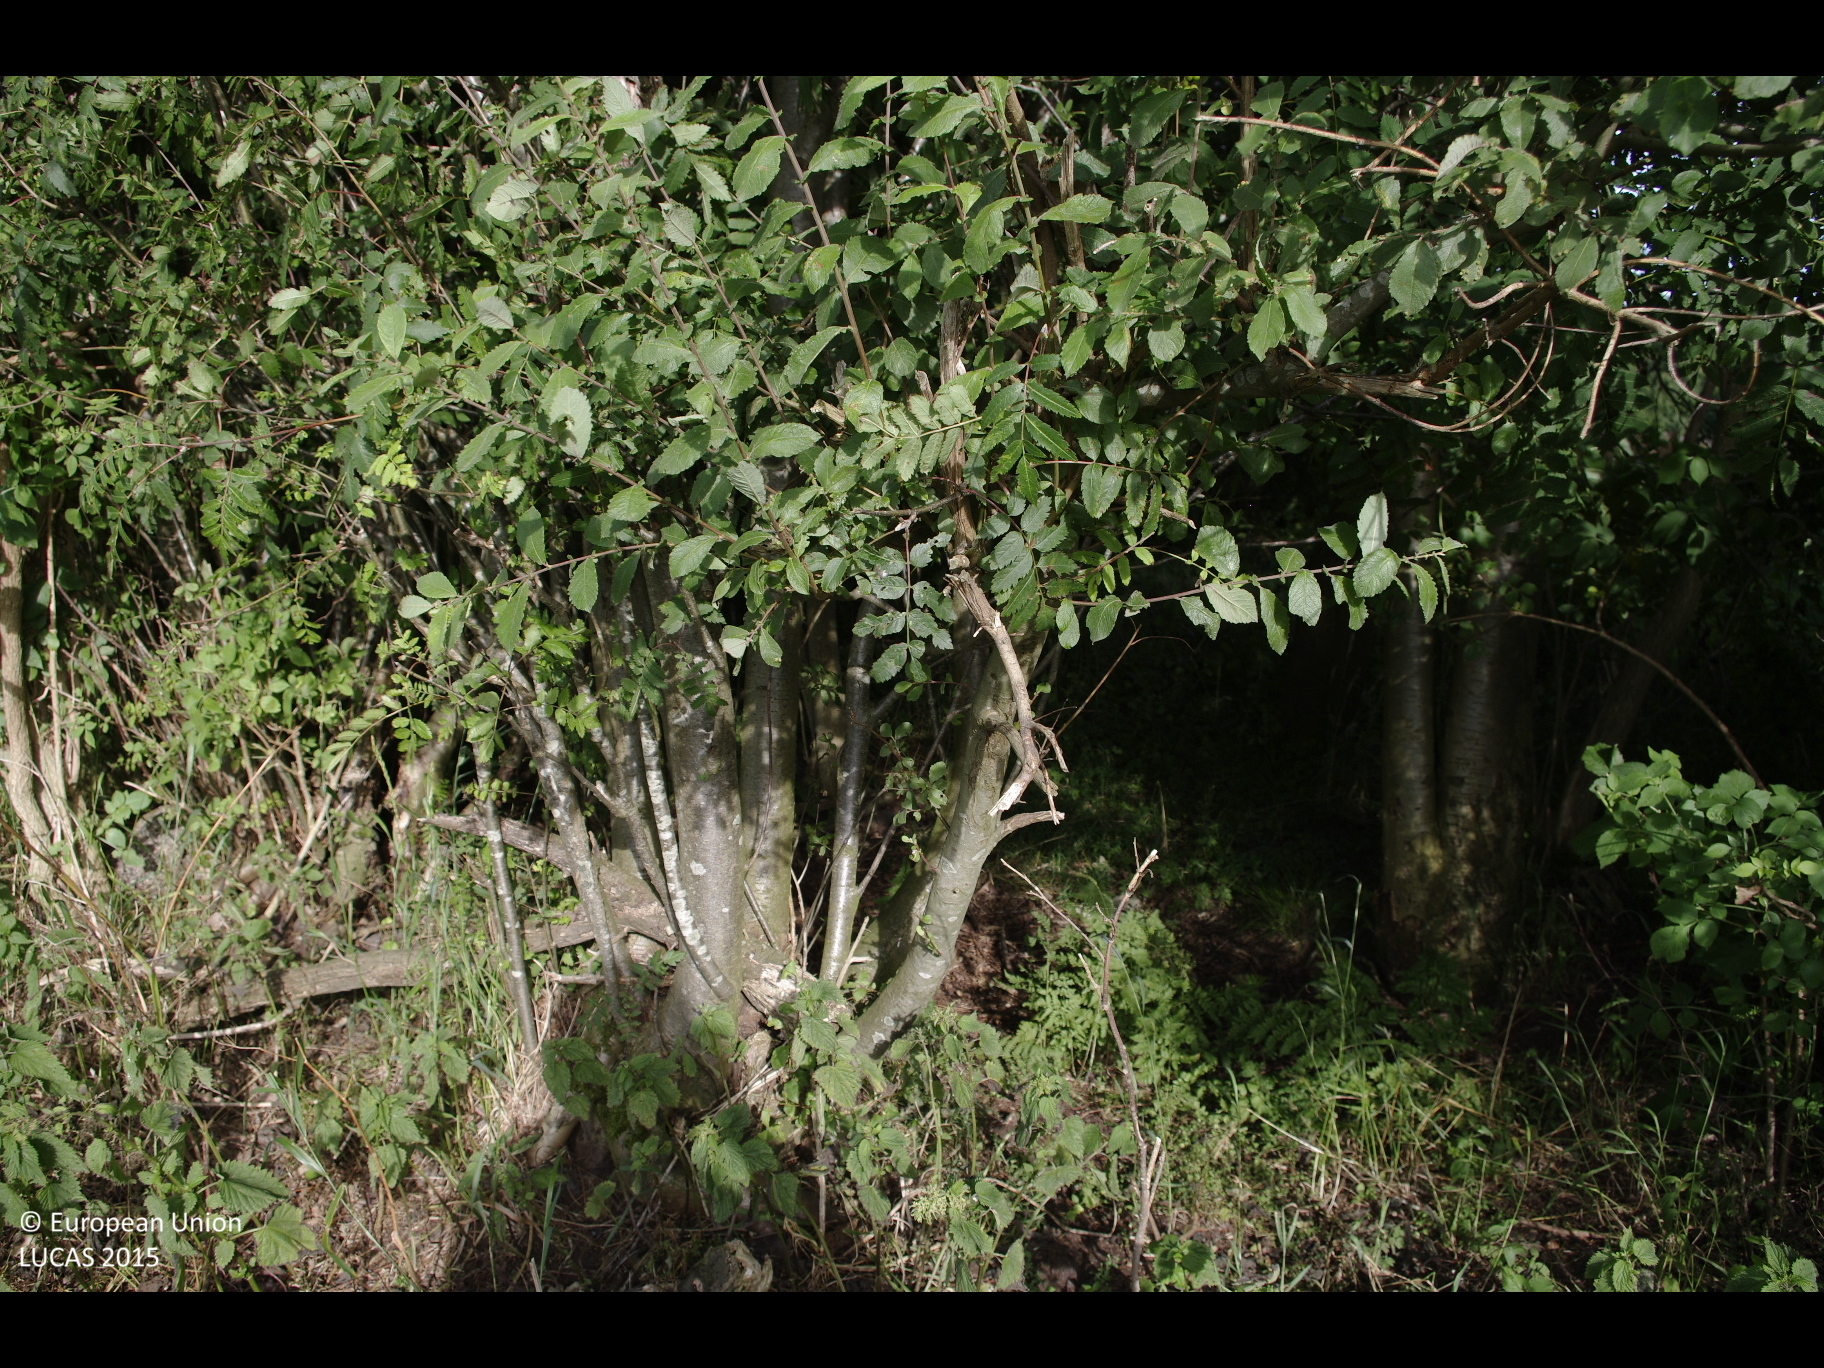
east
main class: Cropland
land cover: Common wheat
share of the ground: > 75 %
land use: Agriculture (excluding fallow land and kitchen gardens)
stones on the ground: < 10 %
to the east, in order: Common wheat; Broadleaved woodland; Tracks; Broadleaved woodland; Grassland without tree/shrub cover; Broadleaved woodland; Grass margins
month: July
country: DE
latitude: 53.9590
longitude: 9.9543
